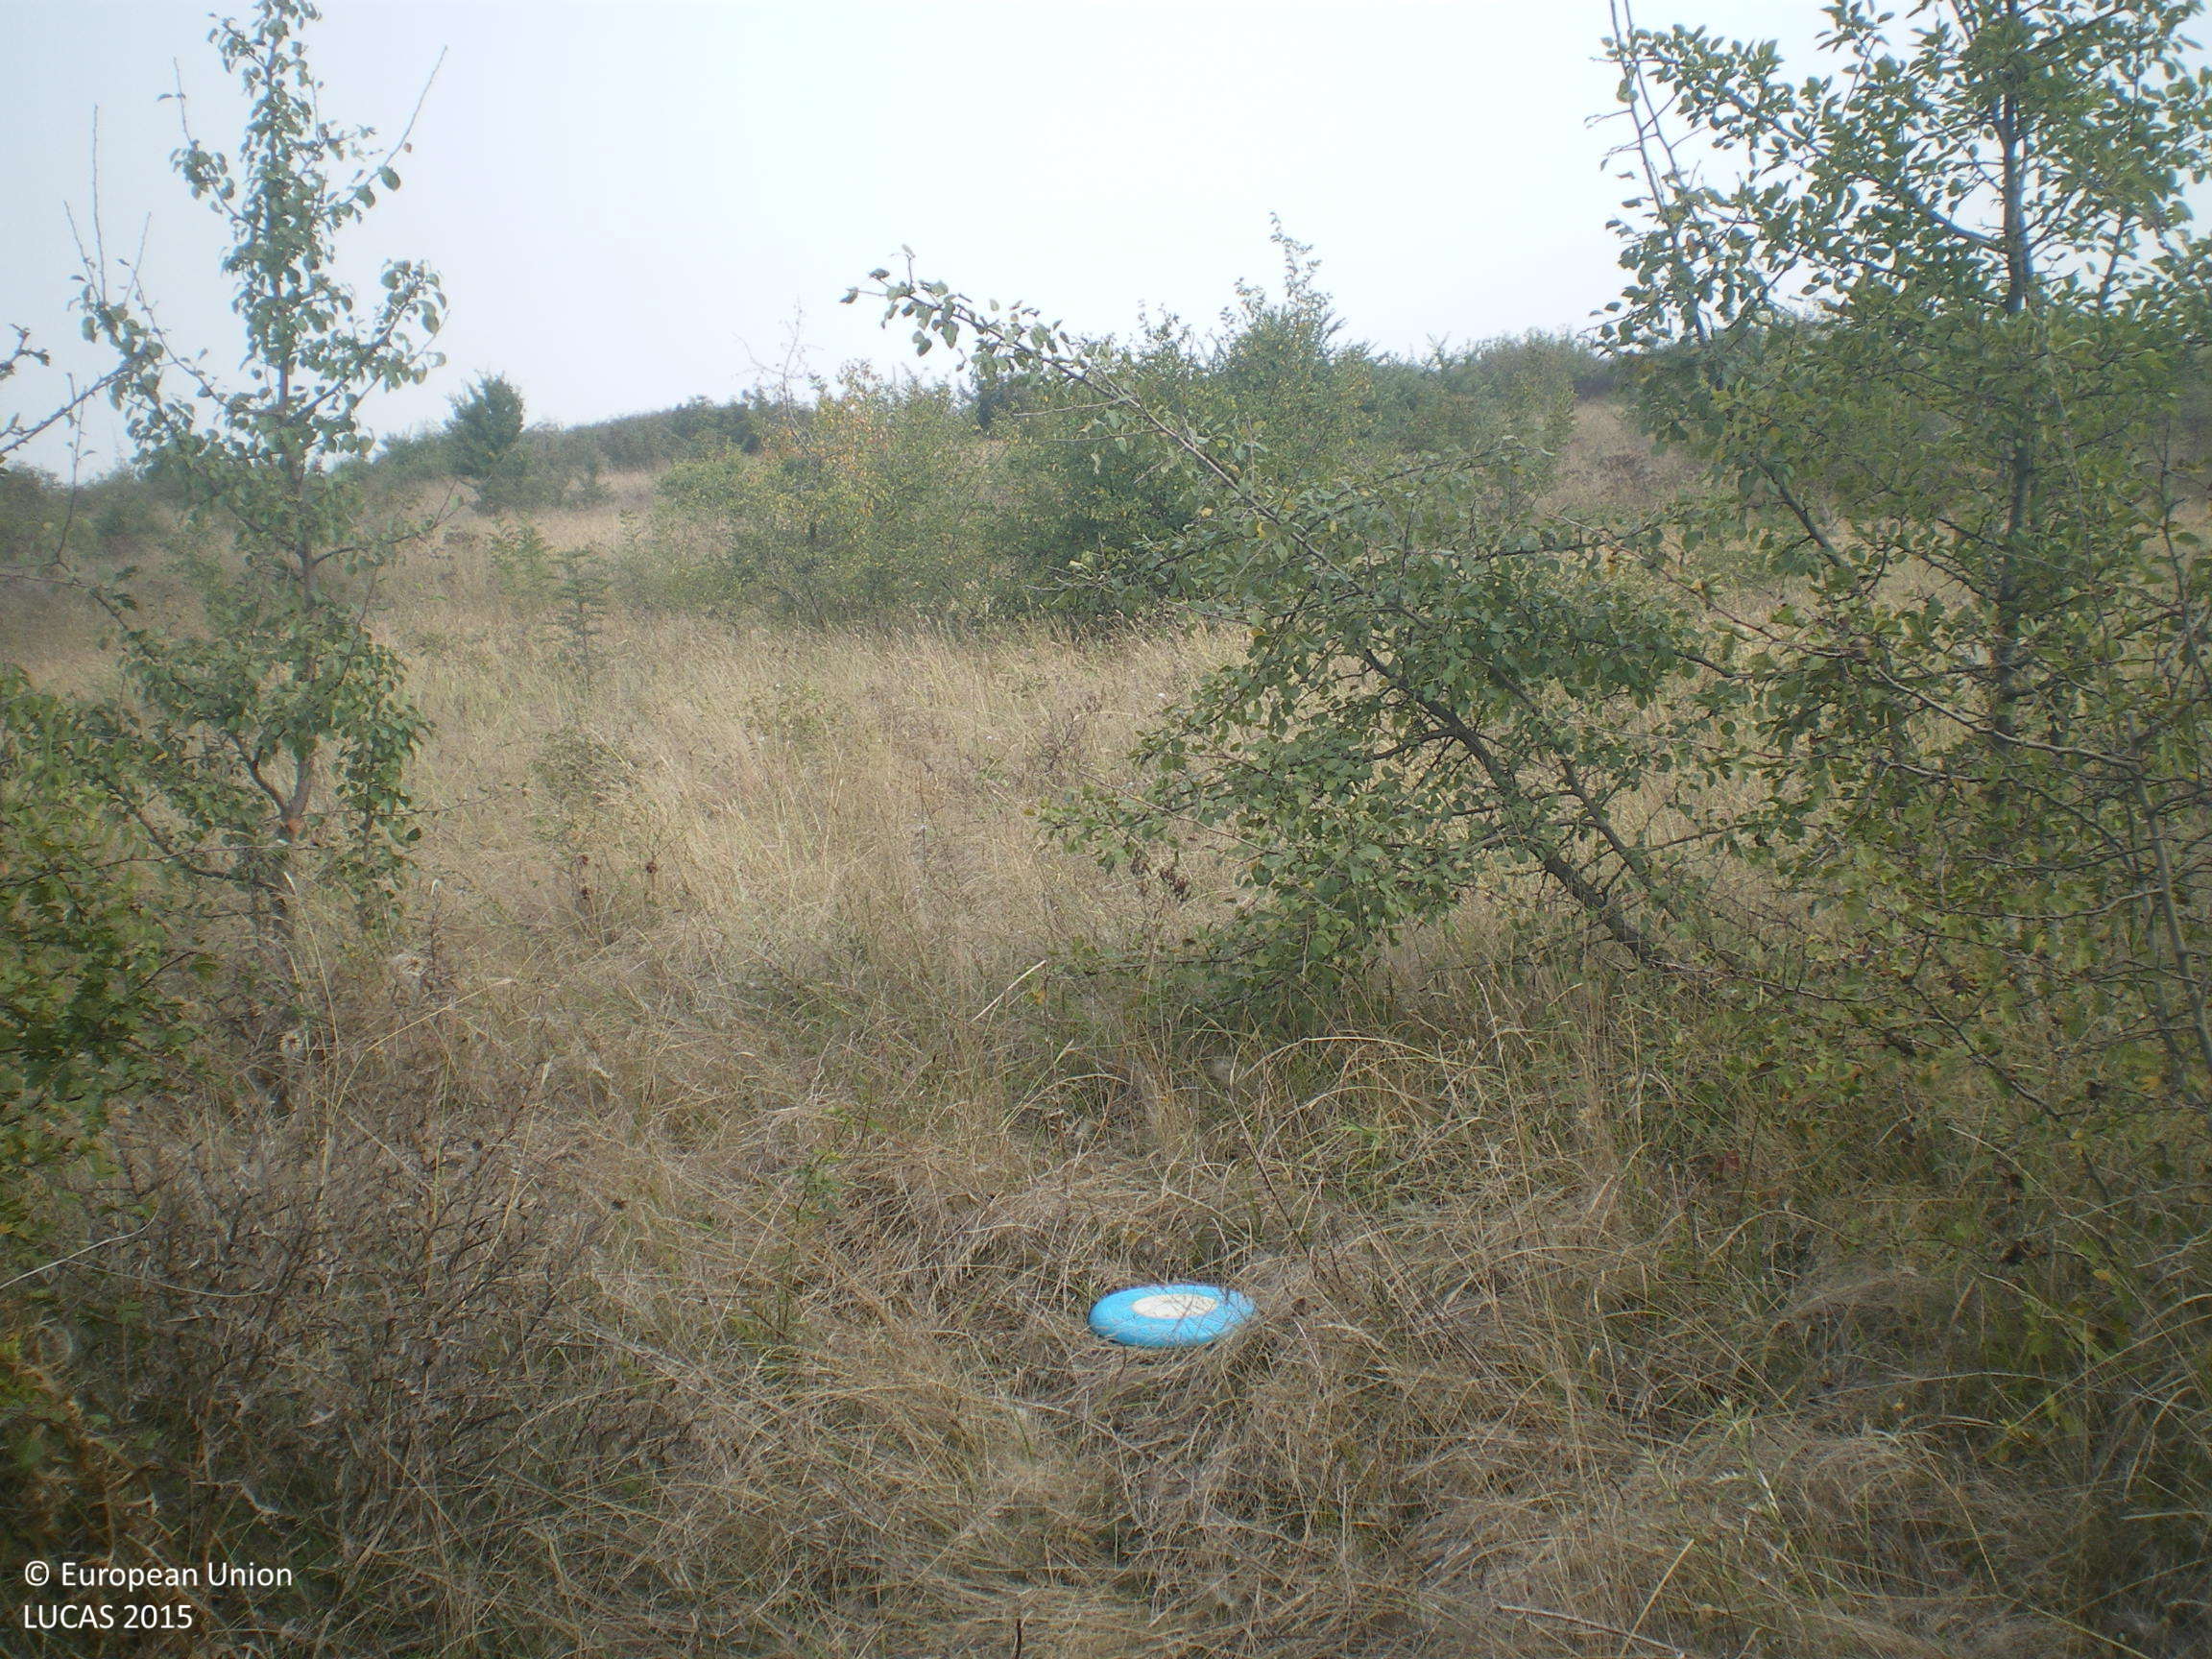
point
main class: Grassland
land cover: Grassland with sparse tree/shrub cover
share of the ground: > 75 %
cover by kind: herbaceous plants 90 %, broadleaved forest trees 5 %, shrubs 5 %
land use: Agriculture (excluding fallow land and kitchen gardens)
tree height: > 5 m
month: September
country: BG
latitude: 42.1009
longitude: 25.9267
